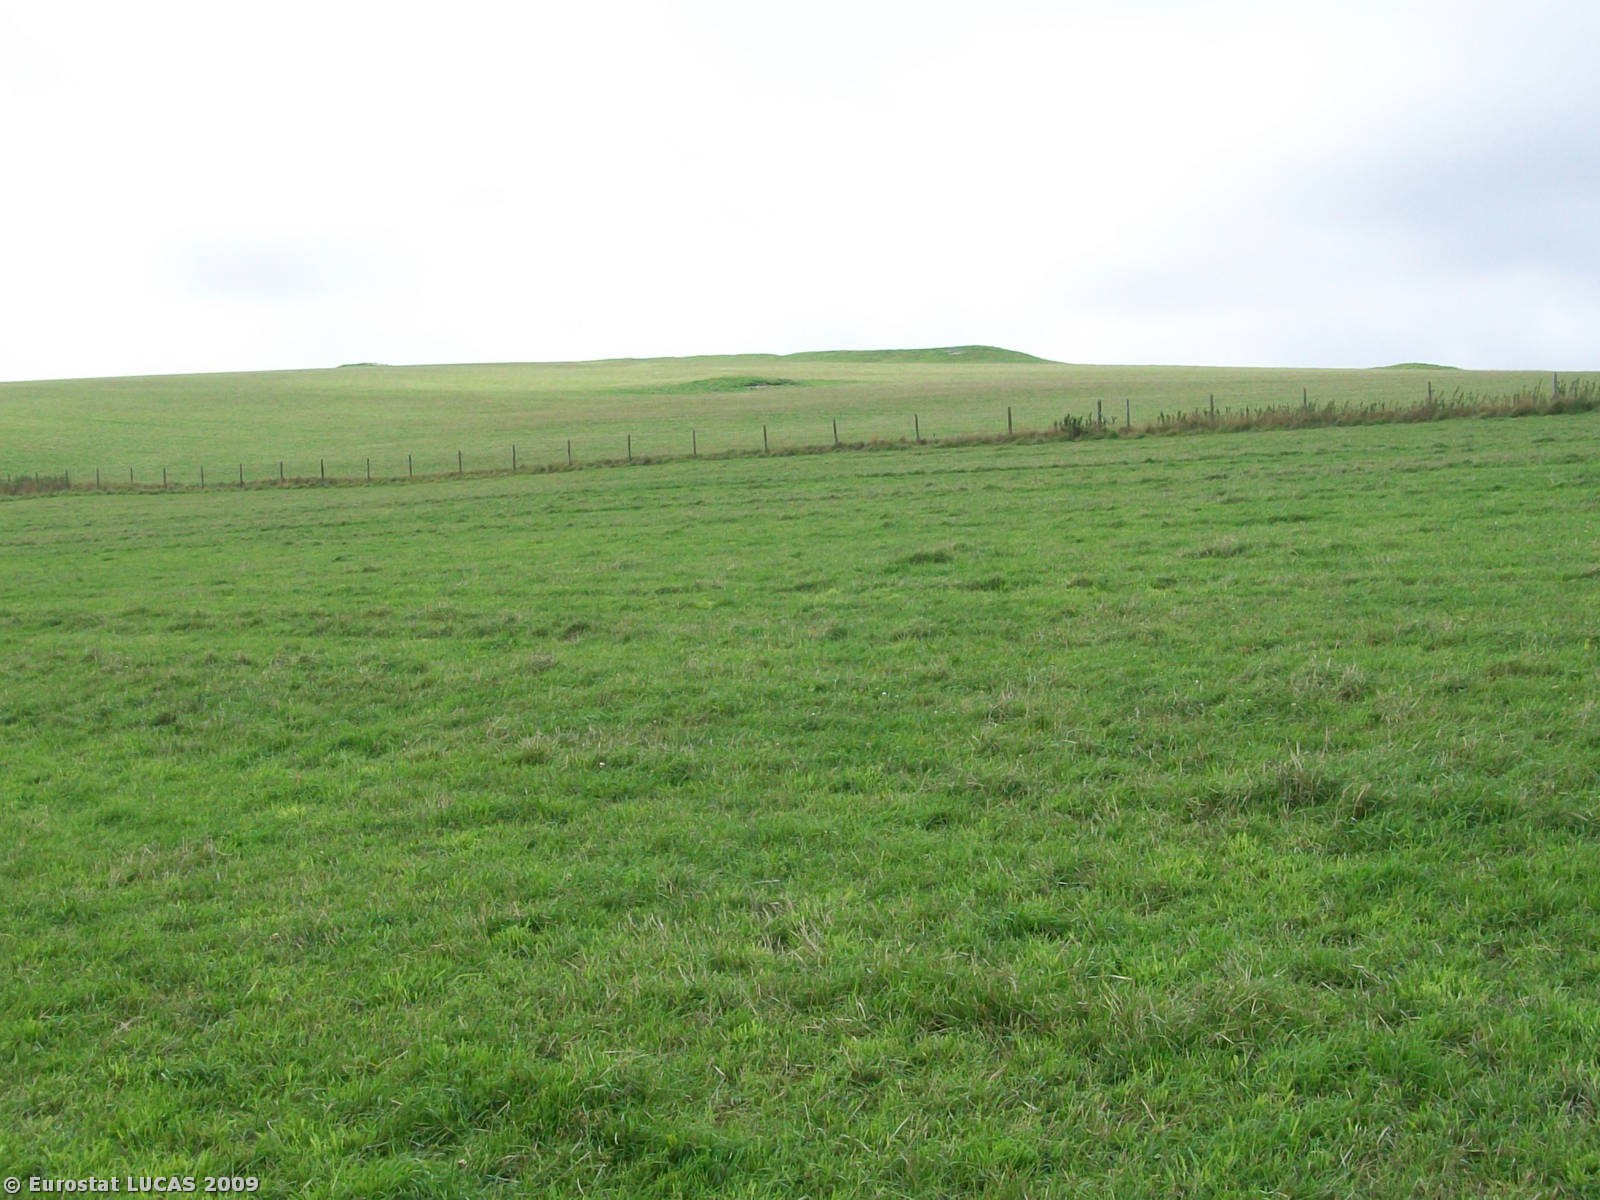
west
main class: Grassland
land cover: Grassland without tree/shrub cover
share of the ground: > 75 %
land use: Agriculture (excluding fallow land and kitchen gardens)
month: July
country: GB
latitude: 50.7193
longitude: -2.6031
